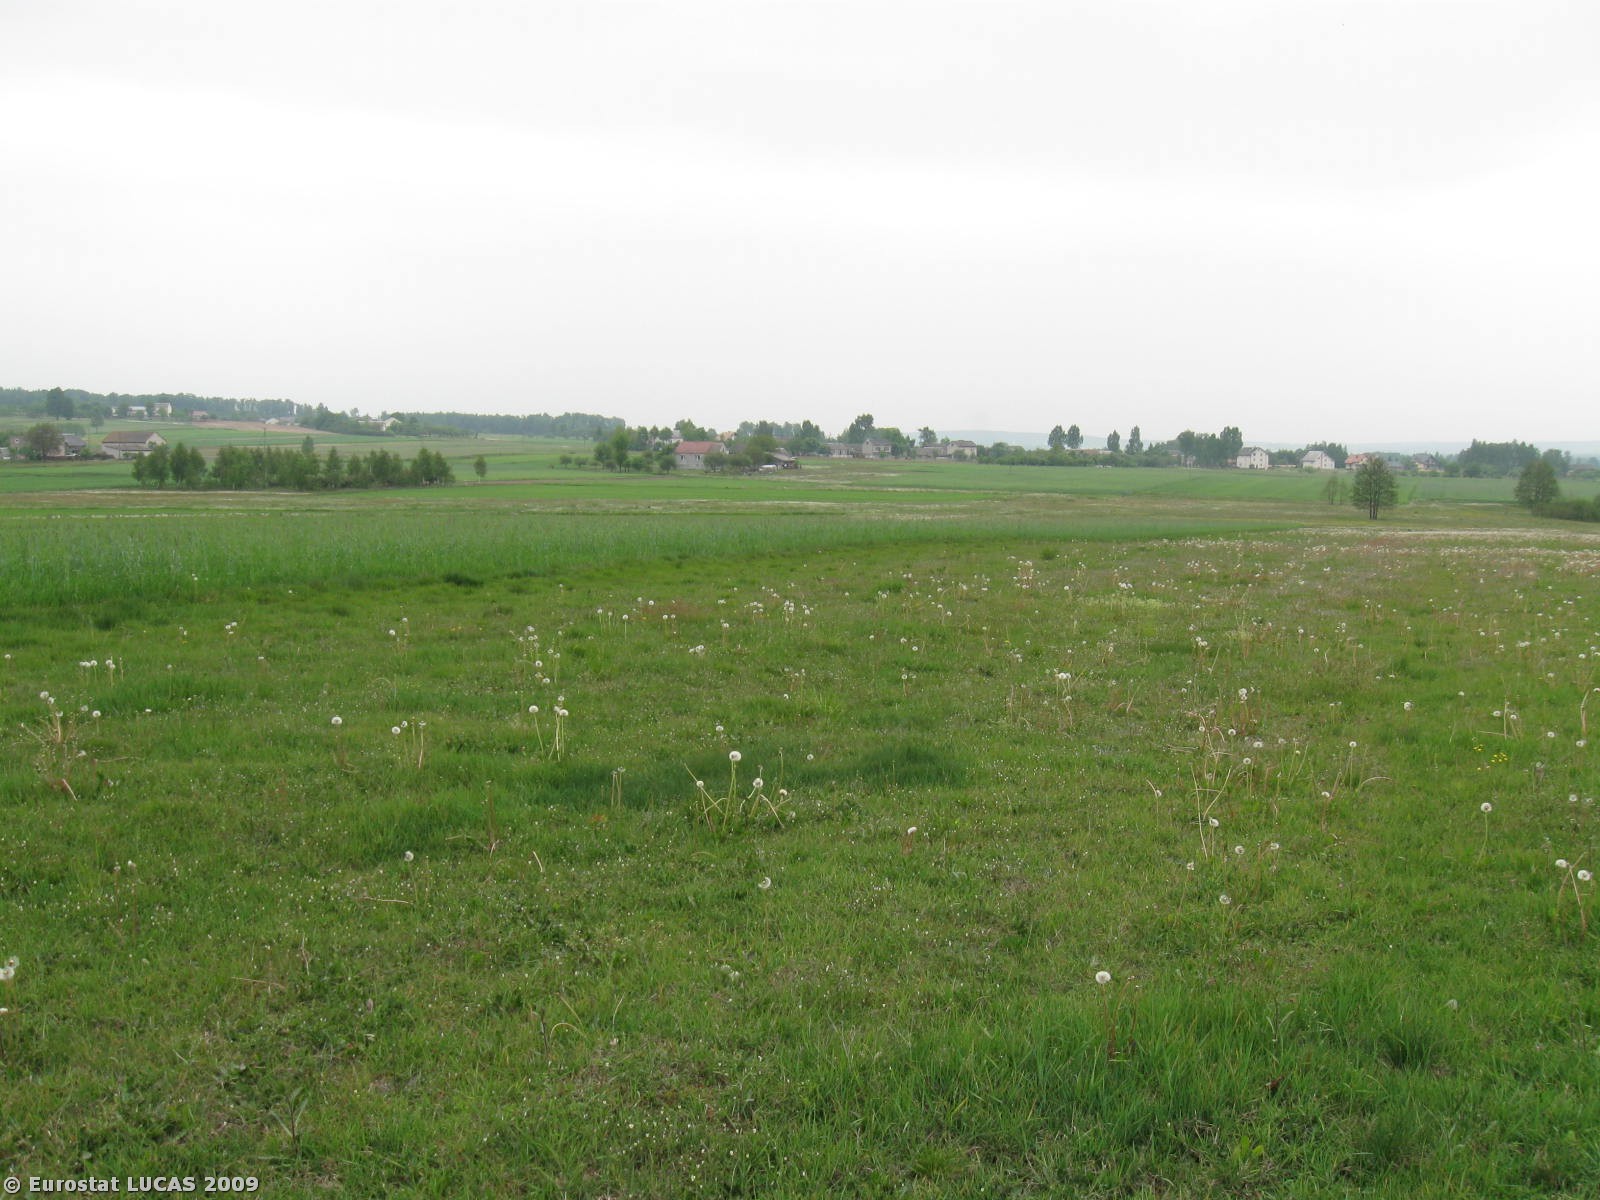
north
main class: Grassland
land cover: Grassland without tree/shrub cover
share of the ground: > 75 %
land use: Agriculture (excluding fallow land and kitchen gardens)
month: May
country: PL
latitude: 51.0103
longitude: 20.4278
